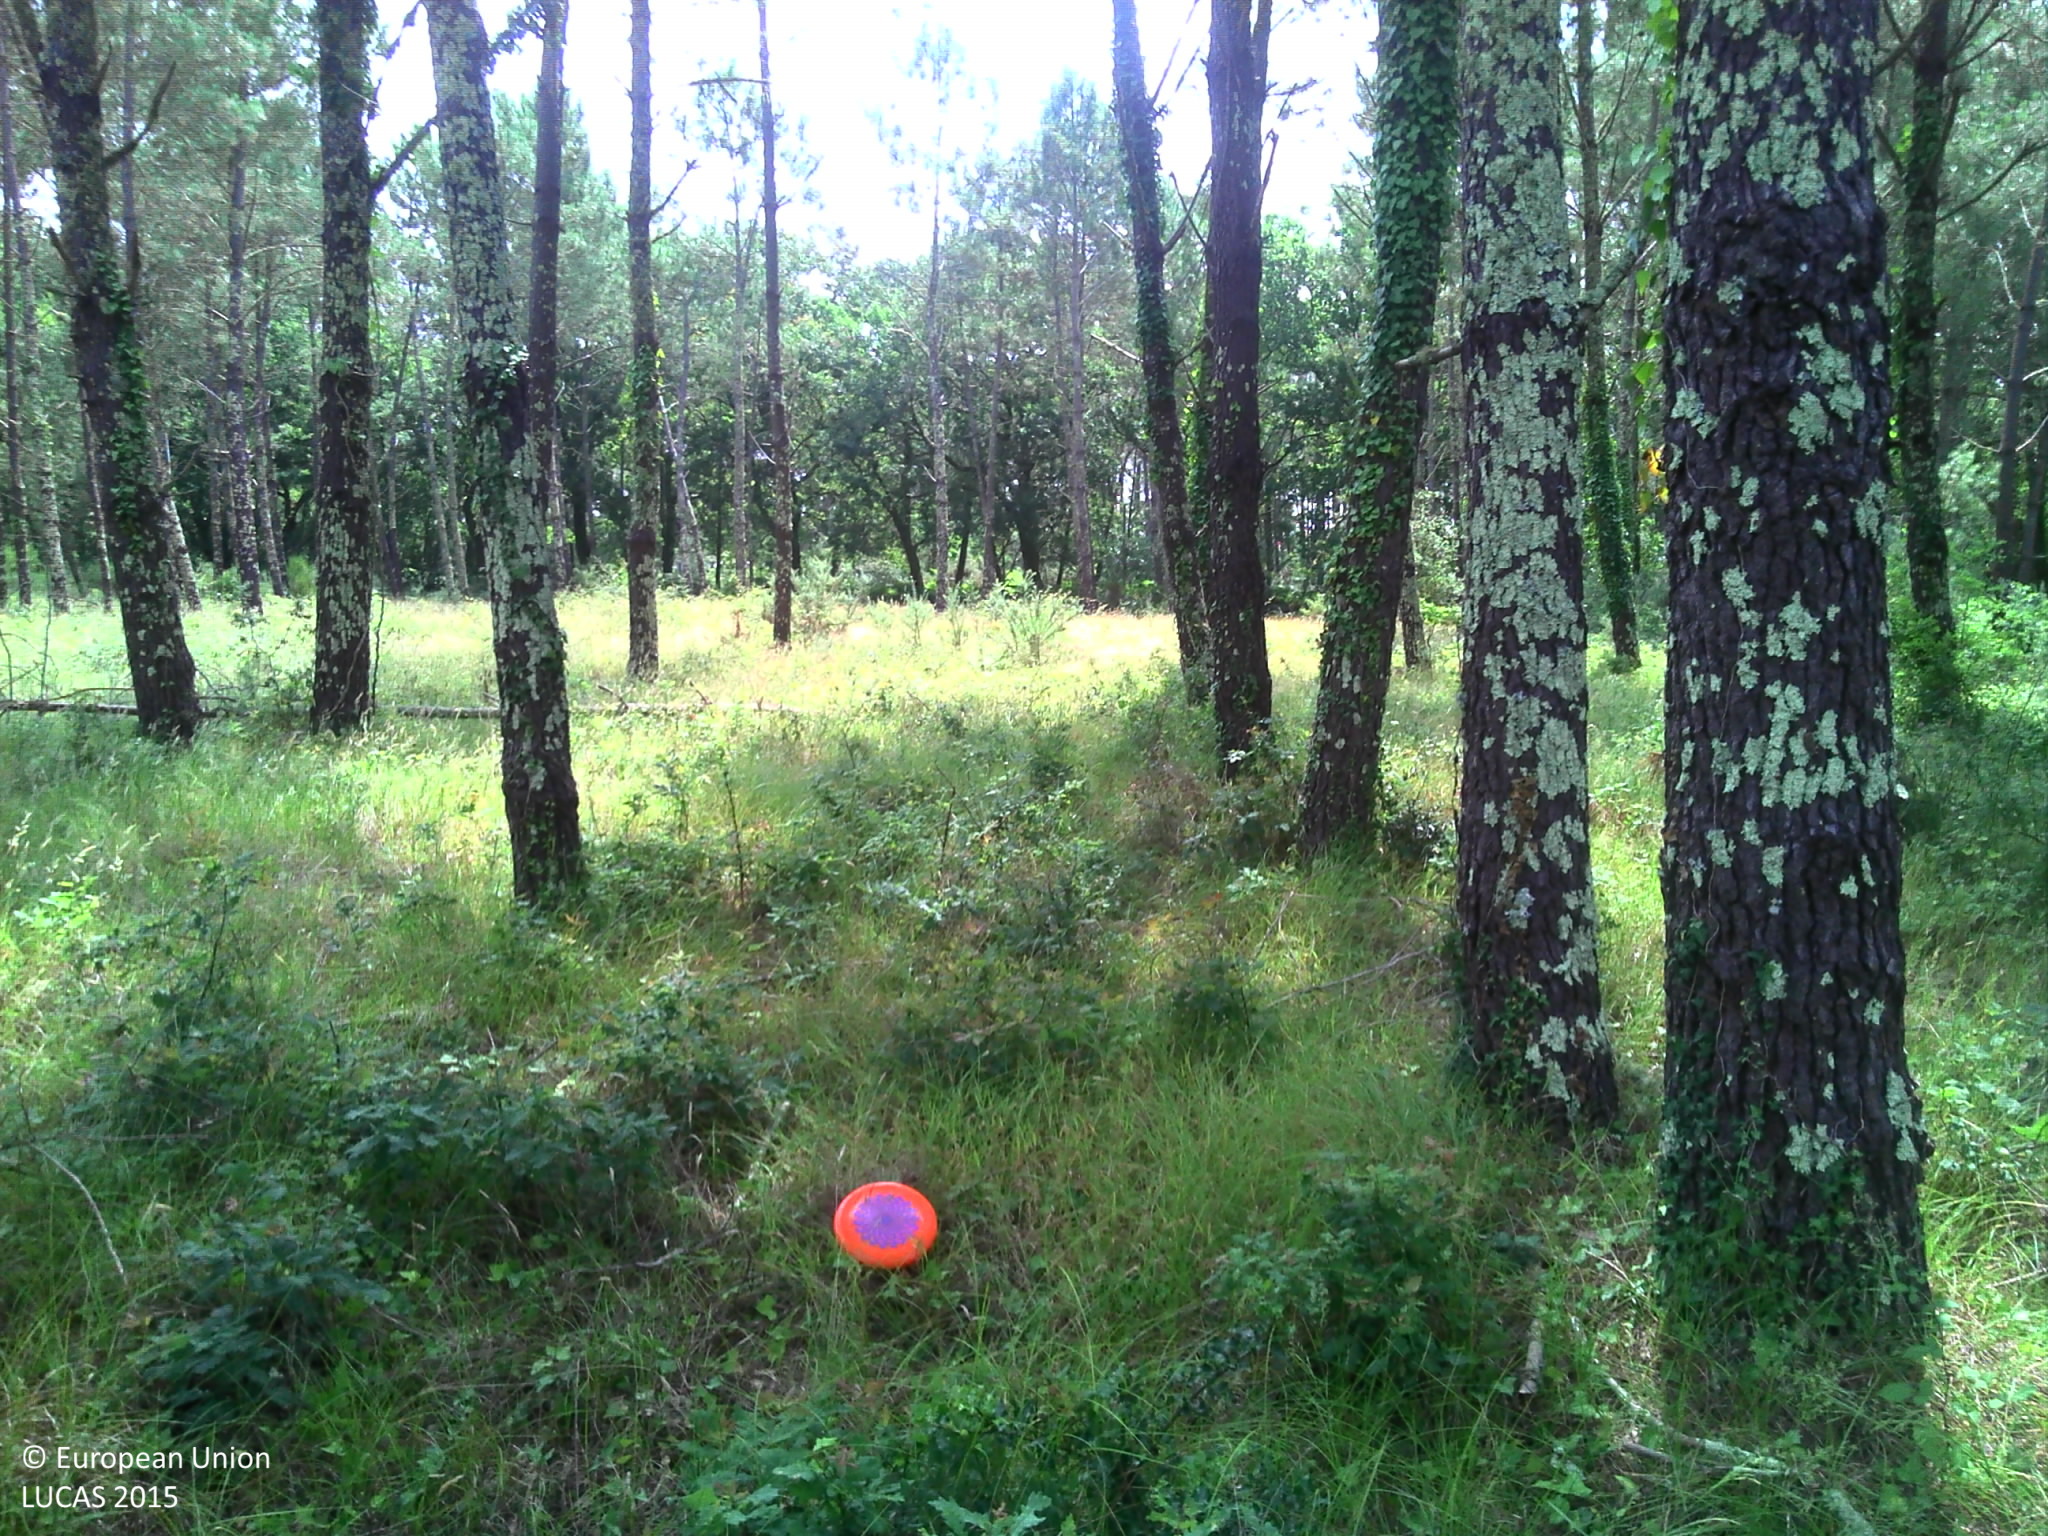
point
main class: Woodland
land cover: Pine dominated coniferous woodland
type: coniferous forest of the mediterranean region
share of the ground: > 75 %
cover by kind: coniferous forest trees 90 %, broadleaved forest trees 5 %, herbaceous plants 5 %
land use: Forestry
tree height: > 5 m
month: July
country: FR
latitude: 43.8048
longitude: -1.2929
